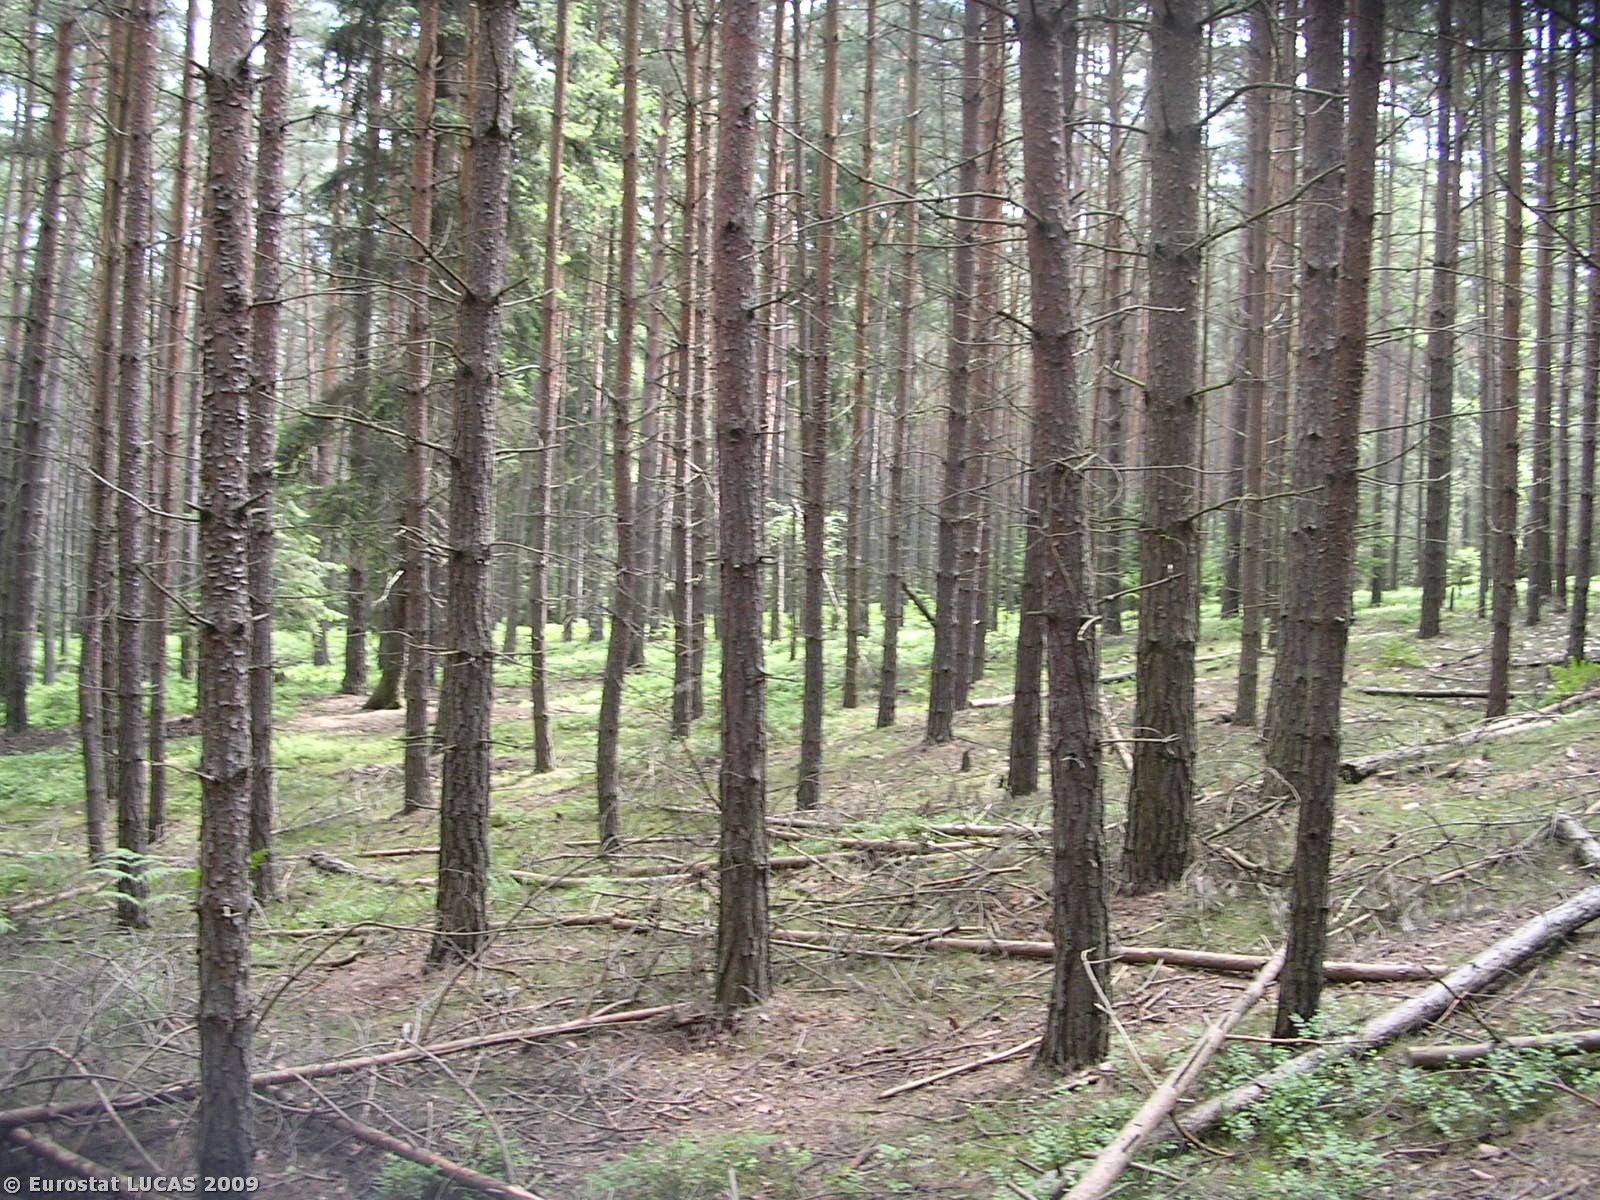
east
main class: Woodland
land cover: Coniferous woodland
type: hemiboreal forest and nemoral coniferous forest and mixed broadleaved-coniferous forest
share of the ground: > 75 %
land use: Forestry
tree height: > 5 m
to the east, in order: Coniferous woodland; Tracks; Coniferous woodland
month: June
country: CZ
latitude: 50.5544
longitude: 14.7307
